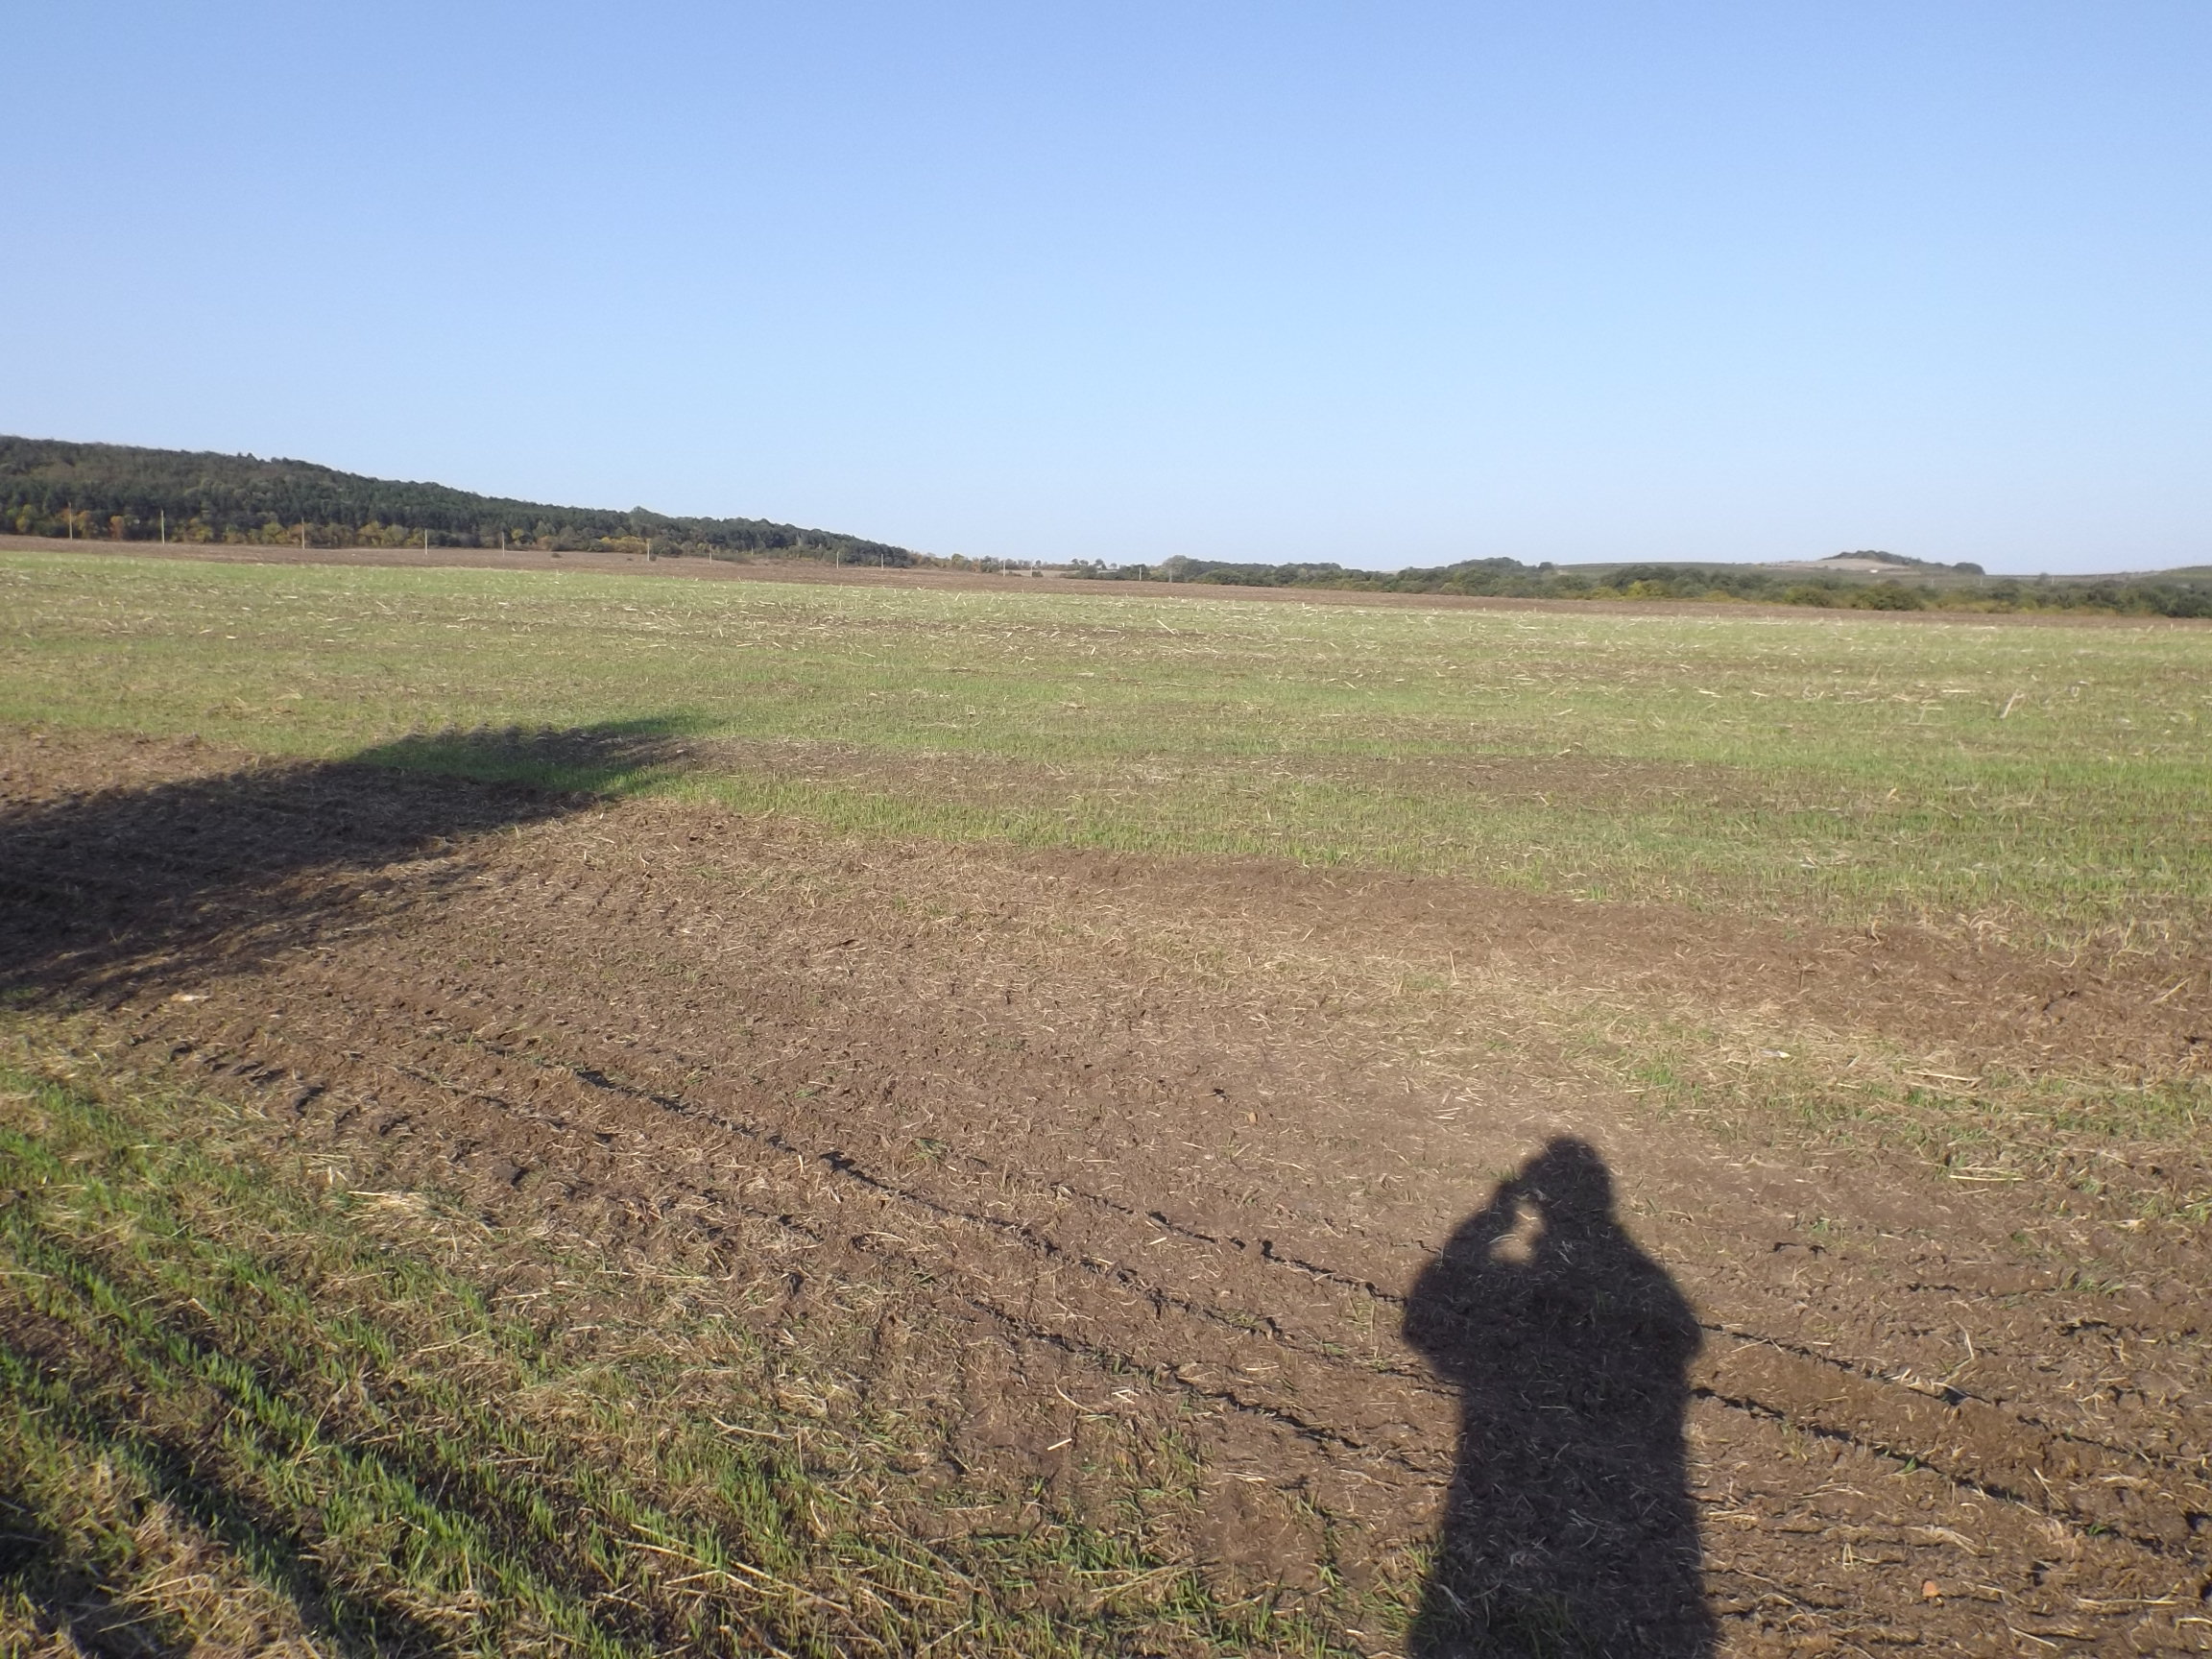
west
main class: Grassland
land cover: Grassland with sparse tree/shrub cover
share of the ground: > 75 %
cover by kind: herbaceous plants 90 %, broadleaved forest trees 5 %, shrubs 5 %
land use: Semi-natural and natural areas not in use
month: October
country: BG
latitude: 42.8931
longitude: 27.8776
